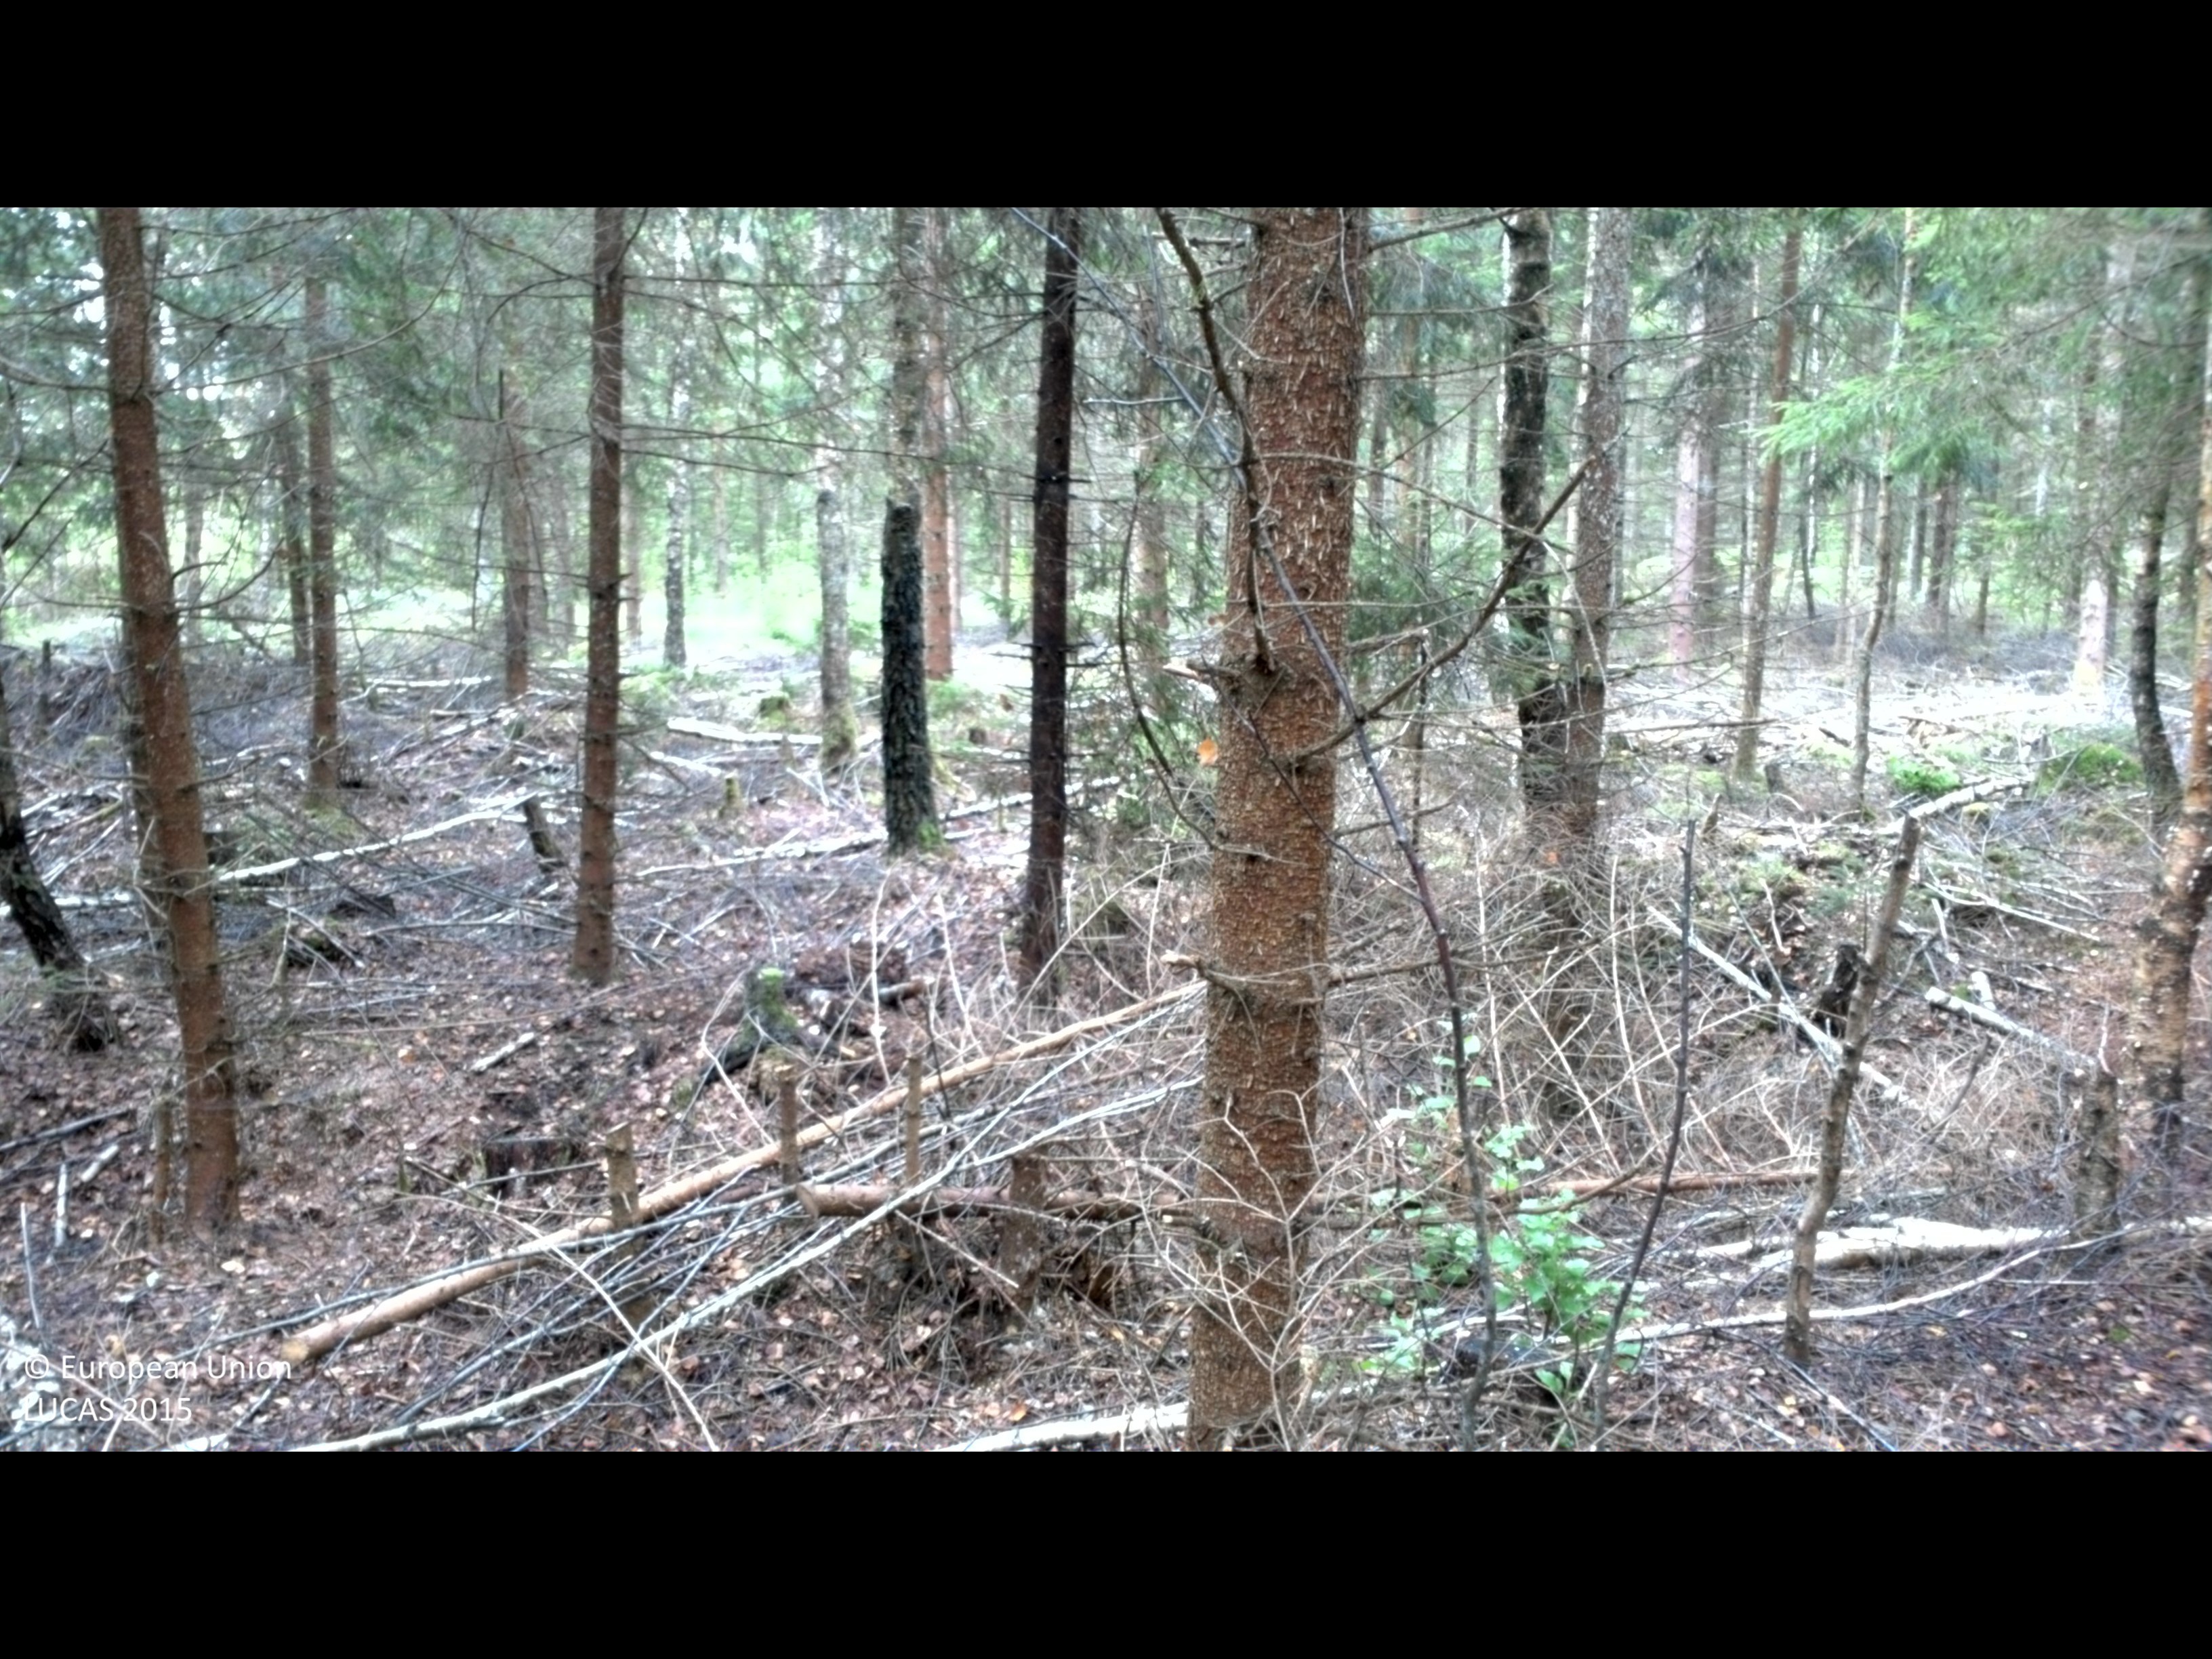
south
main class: Woodland
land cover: Spruce dominated mixed woodland
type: boreal forest
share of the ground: 50 - 75 %
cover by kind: coniferous forest trees 50 %, broadleaved forest trees 20 %
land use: Forestry
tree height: > 5 m
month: August
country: SE
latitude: 56.3356
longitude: 14.1869
